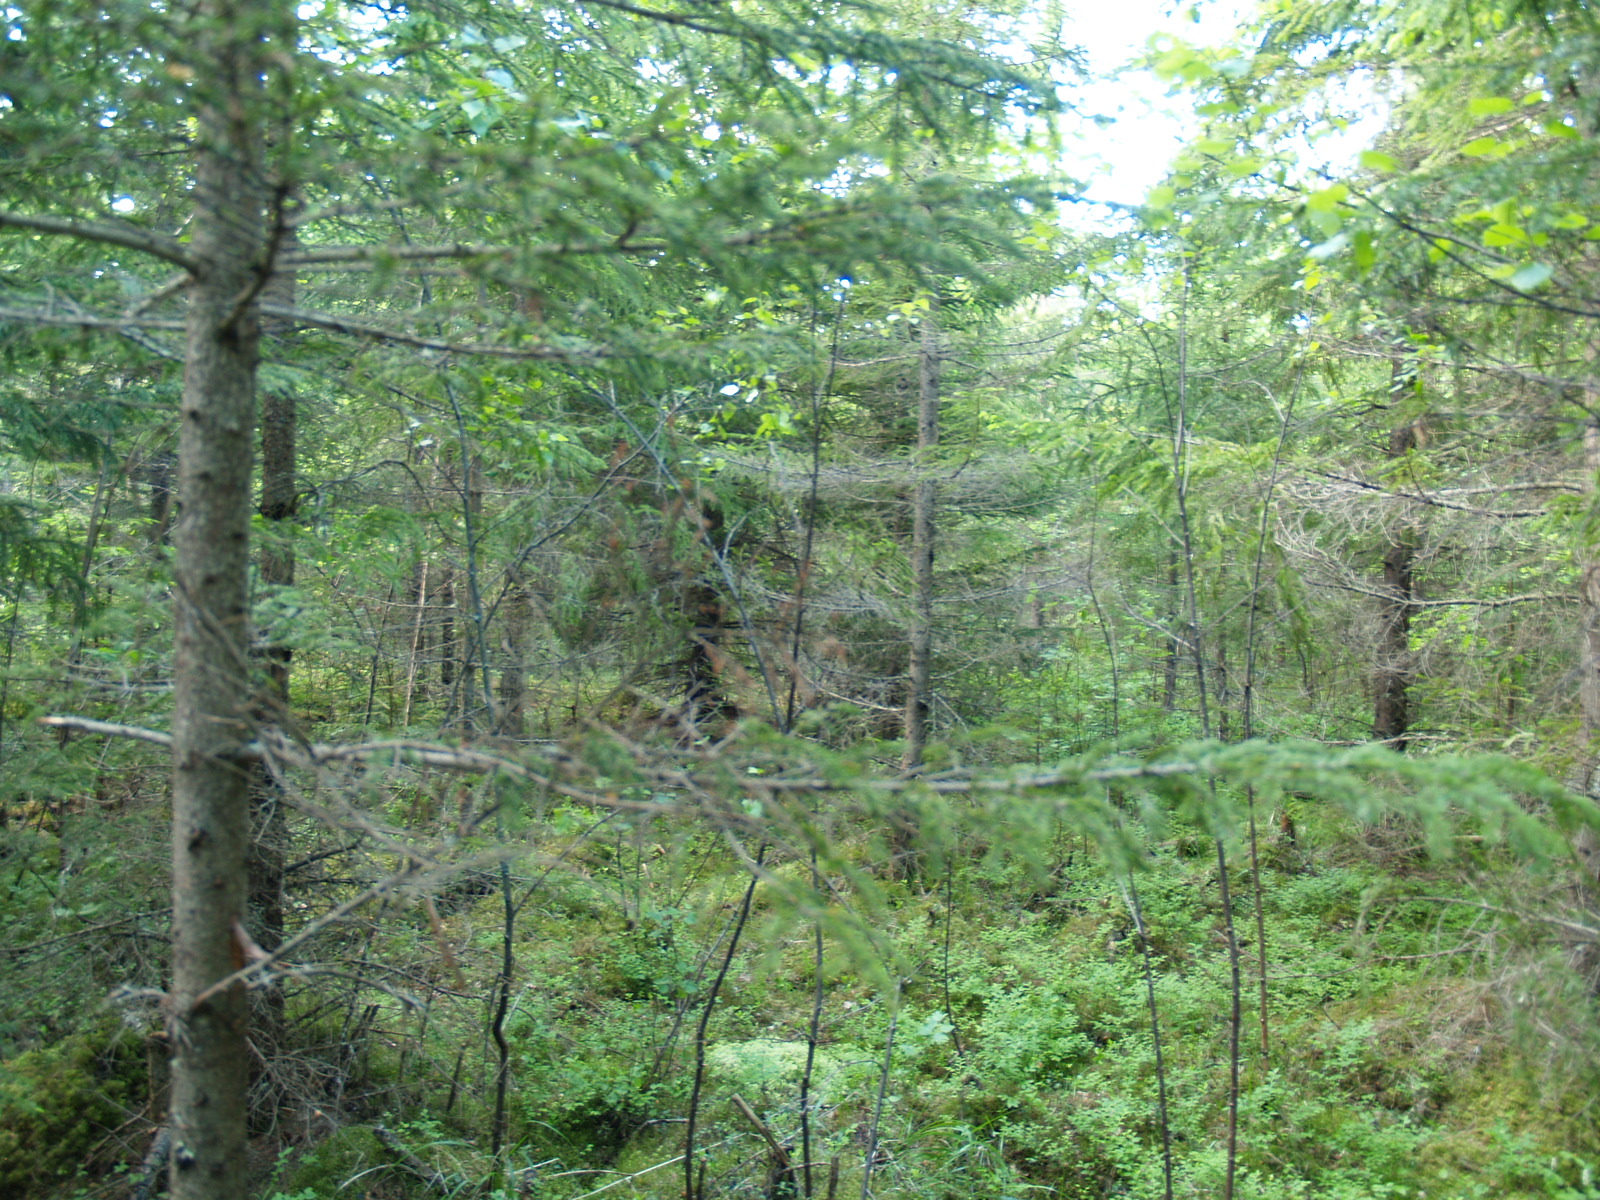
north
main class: Woodland
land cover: Spruce dominated coniferous woodland
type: hemiboreal forest and nemoral coniferous forest and mixed broadleaved-coniferous forest
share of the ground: > 75 %
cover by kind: coniferous forest trees 80 %, herbaceous plants 10 %, broadleaved forest trees 5 %, lichens and mosses 5 %
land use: Forestry
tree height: > 5 m
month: June
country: LV
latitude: 56.6353
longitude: 25.6274
